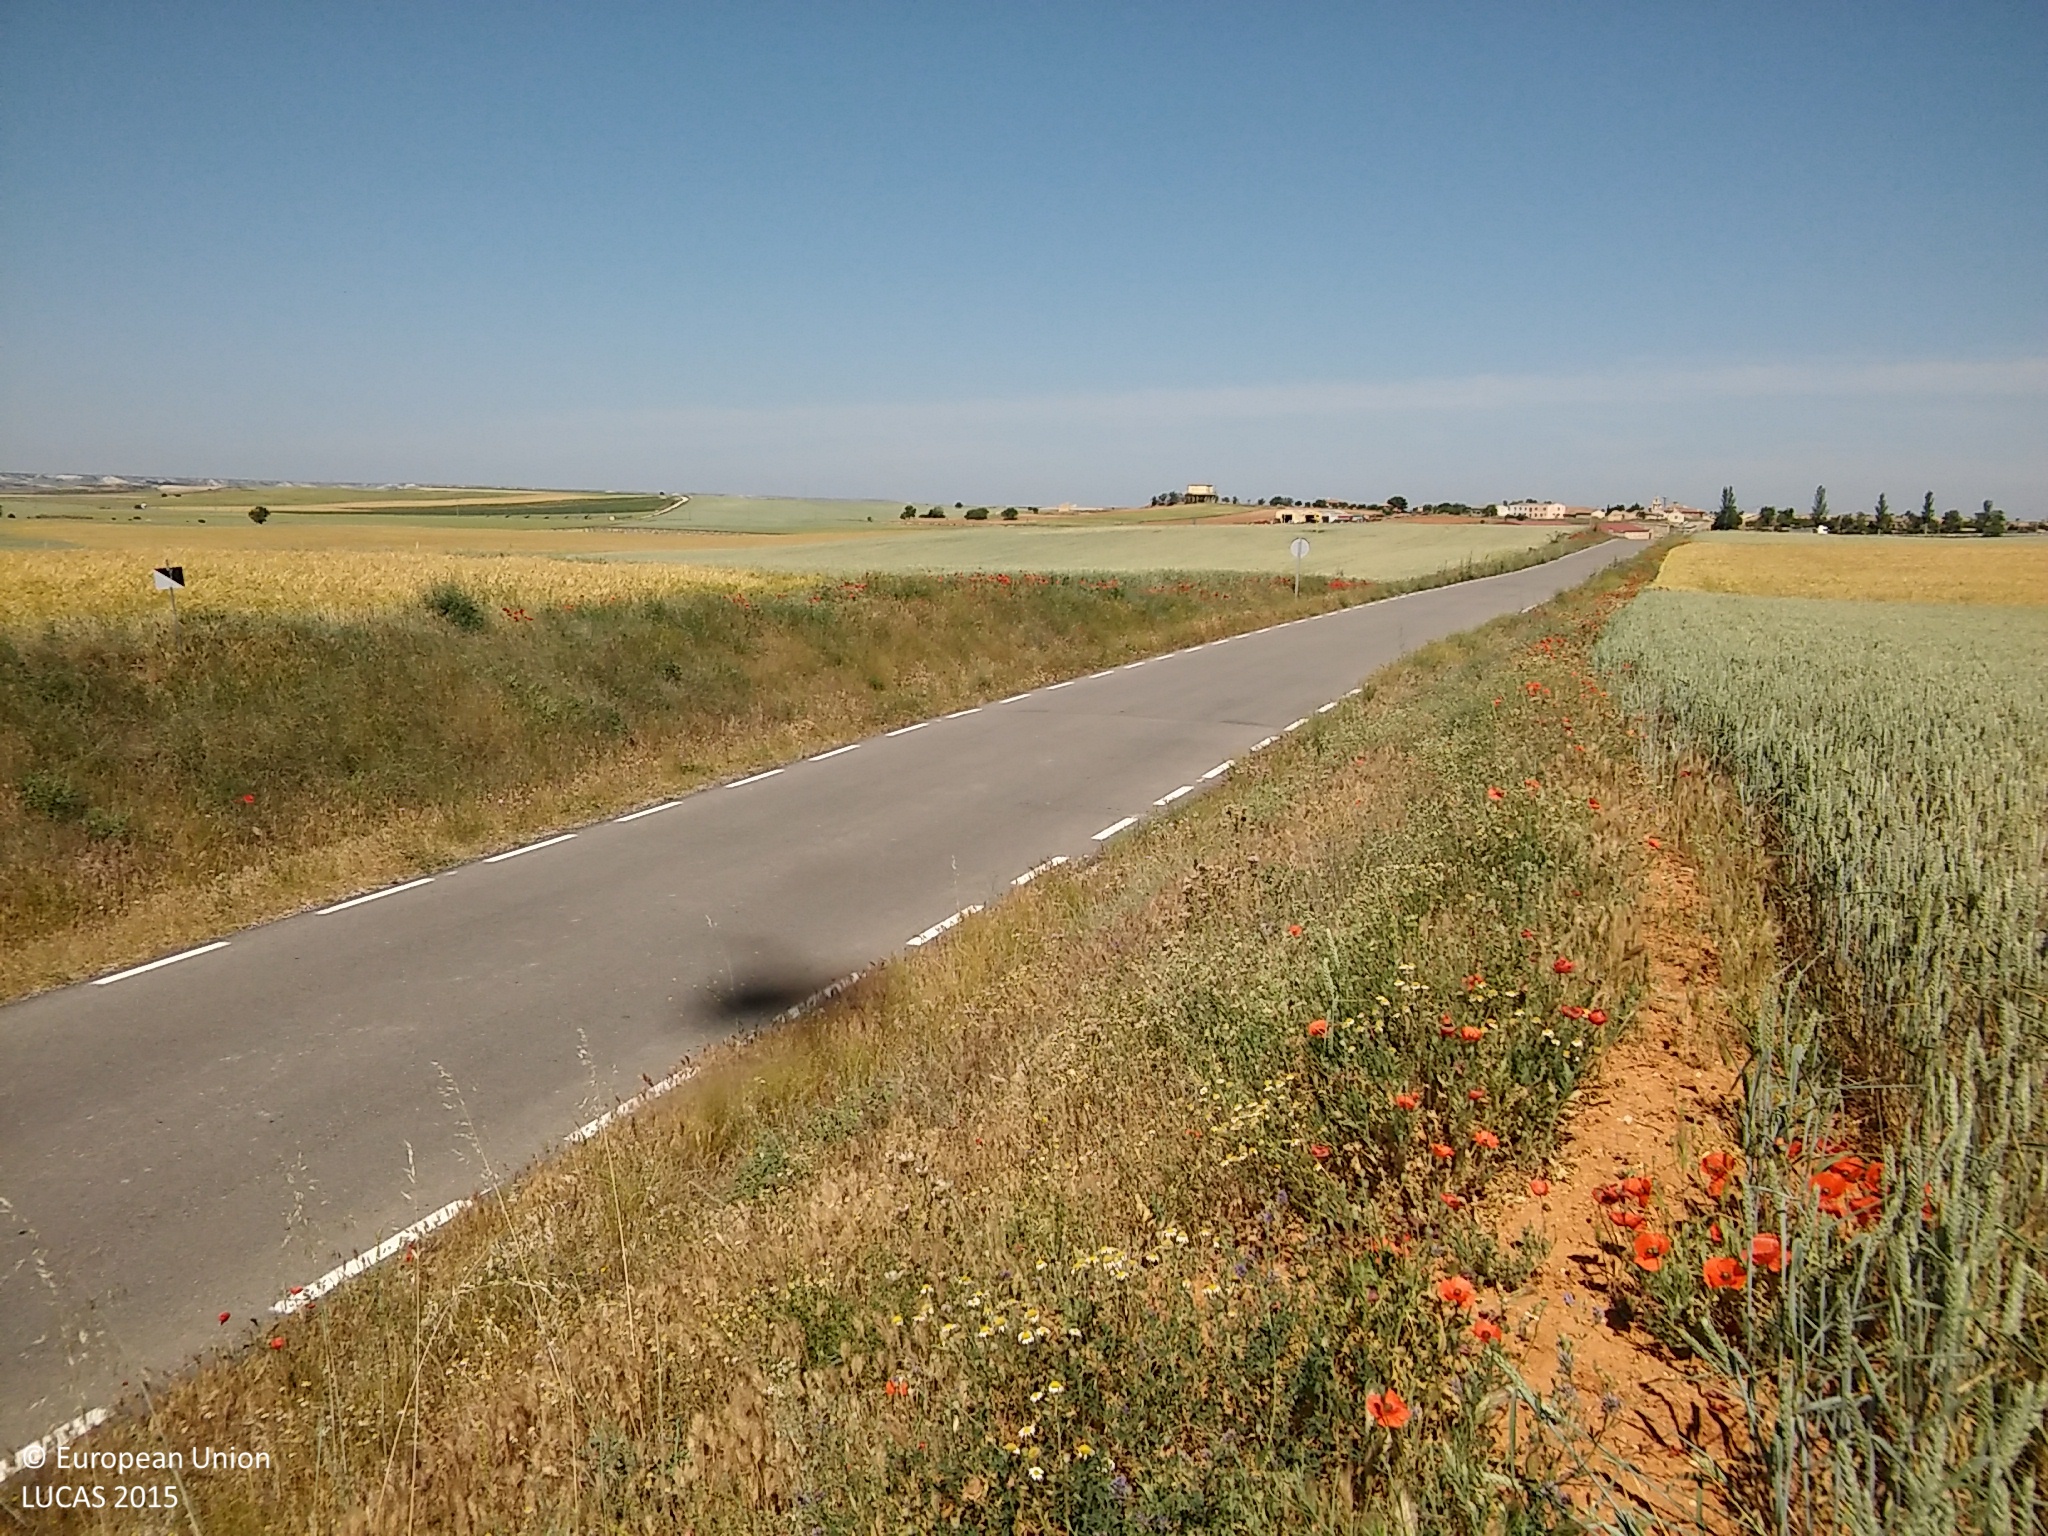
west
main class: Cropland
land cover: Common wheat
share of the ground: 50 - 75 %
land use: Agriculture (excluding fallow land and kitchen gardens)
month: June
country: ES
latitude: 41.6057
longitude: -3.7193
